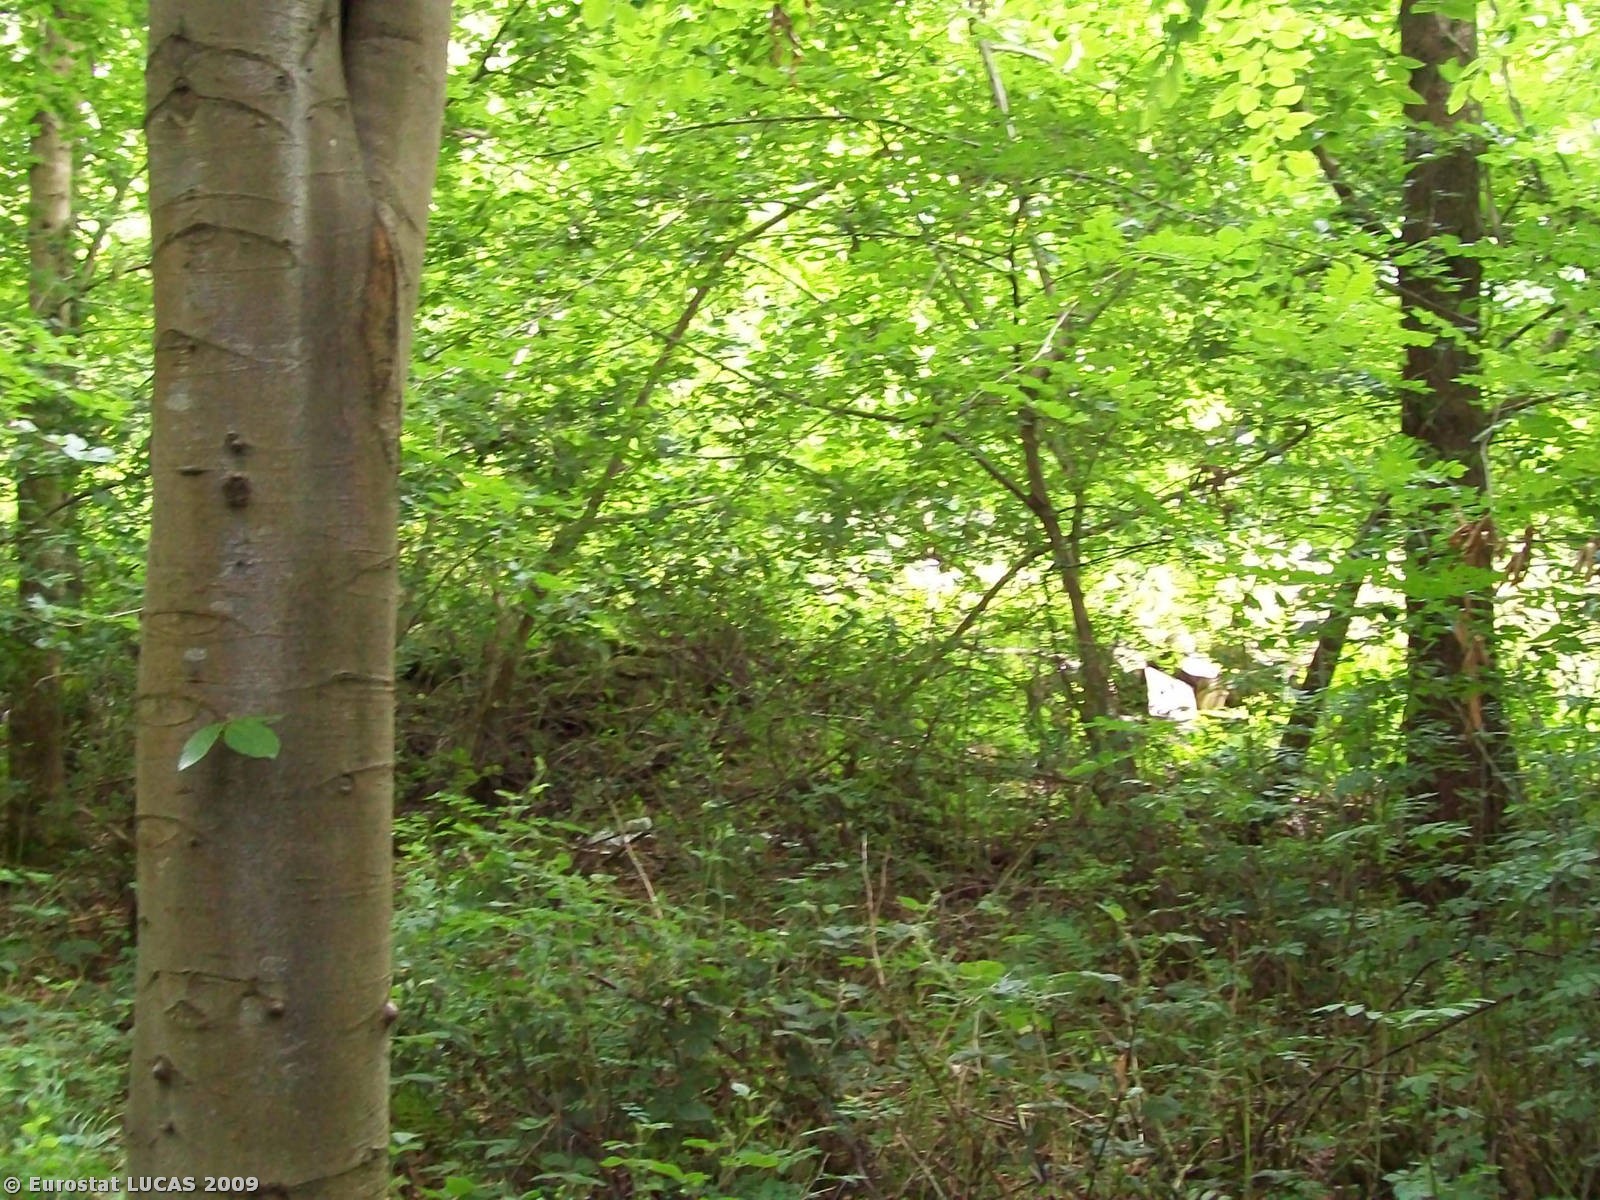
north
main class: Woodland
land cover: Broadleaved woodland
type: mesophytic deciduous forest
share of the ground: > 75 %
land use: Forestry
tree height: > 5 m
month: June
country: GB
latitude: 51.3429
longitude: -2.2215
